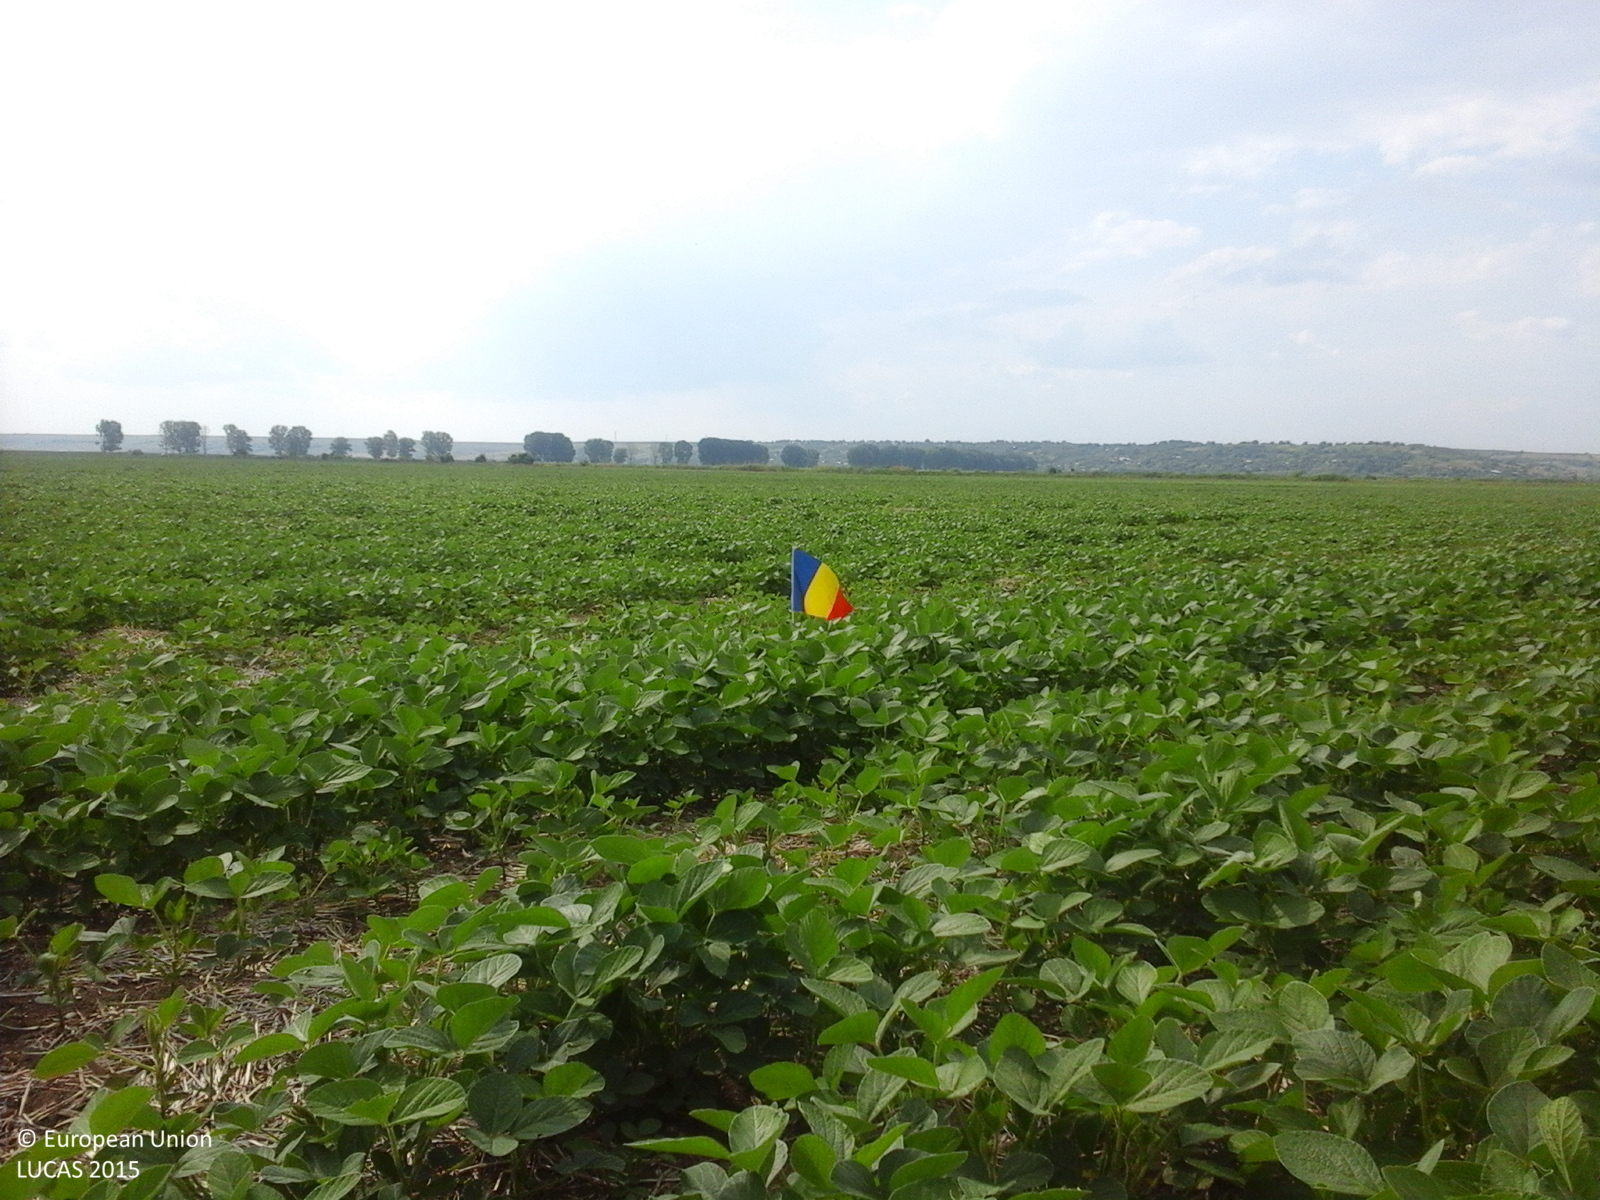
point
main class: Cropland
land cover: Soya
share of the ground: > 75 %
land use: Agriculture (excluding fallow land and kitchen gardens)
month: June
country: RO
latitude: 44.0562
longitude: 26.2191
